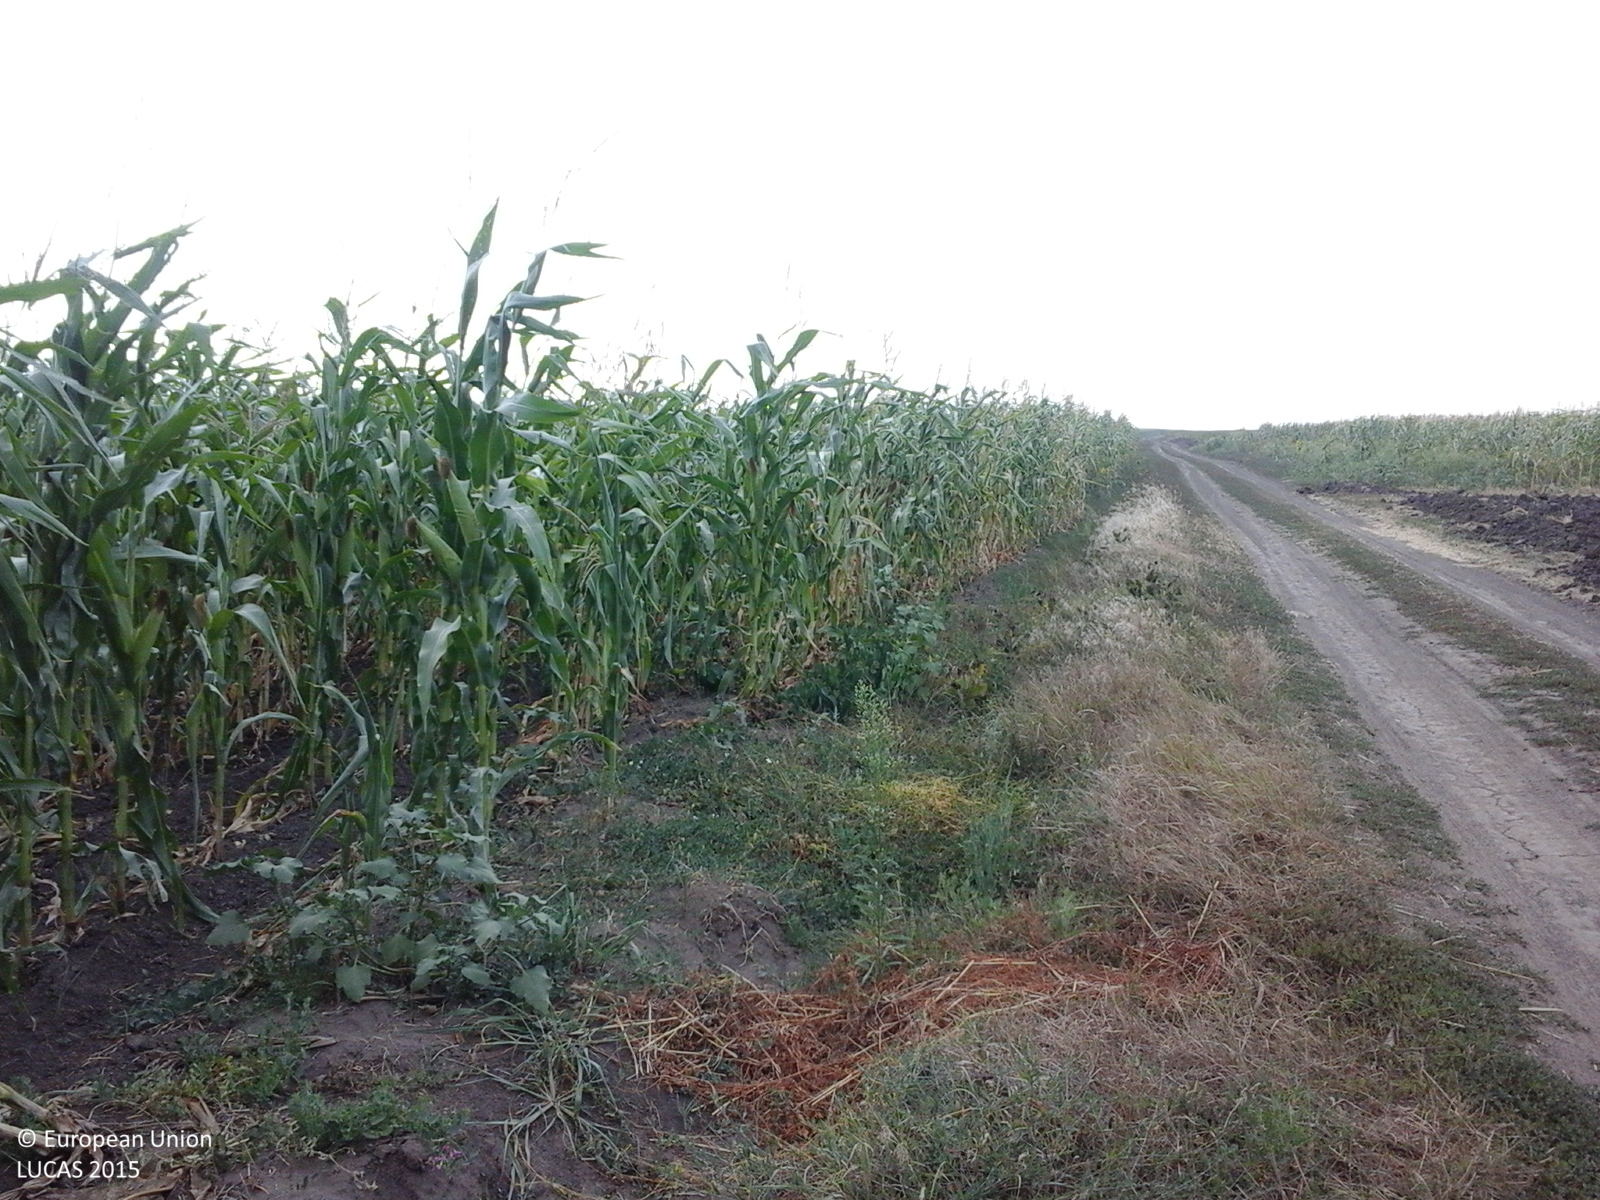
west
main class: Cropland
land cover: Maize
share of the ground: > 75 %
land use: Agriculture (excluding fallow land and kitchen gardens)
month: July
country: RO
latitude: 45.8689
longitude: 27.6157
